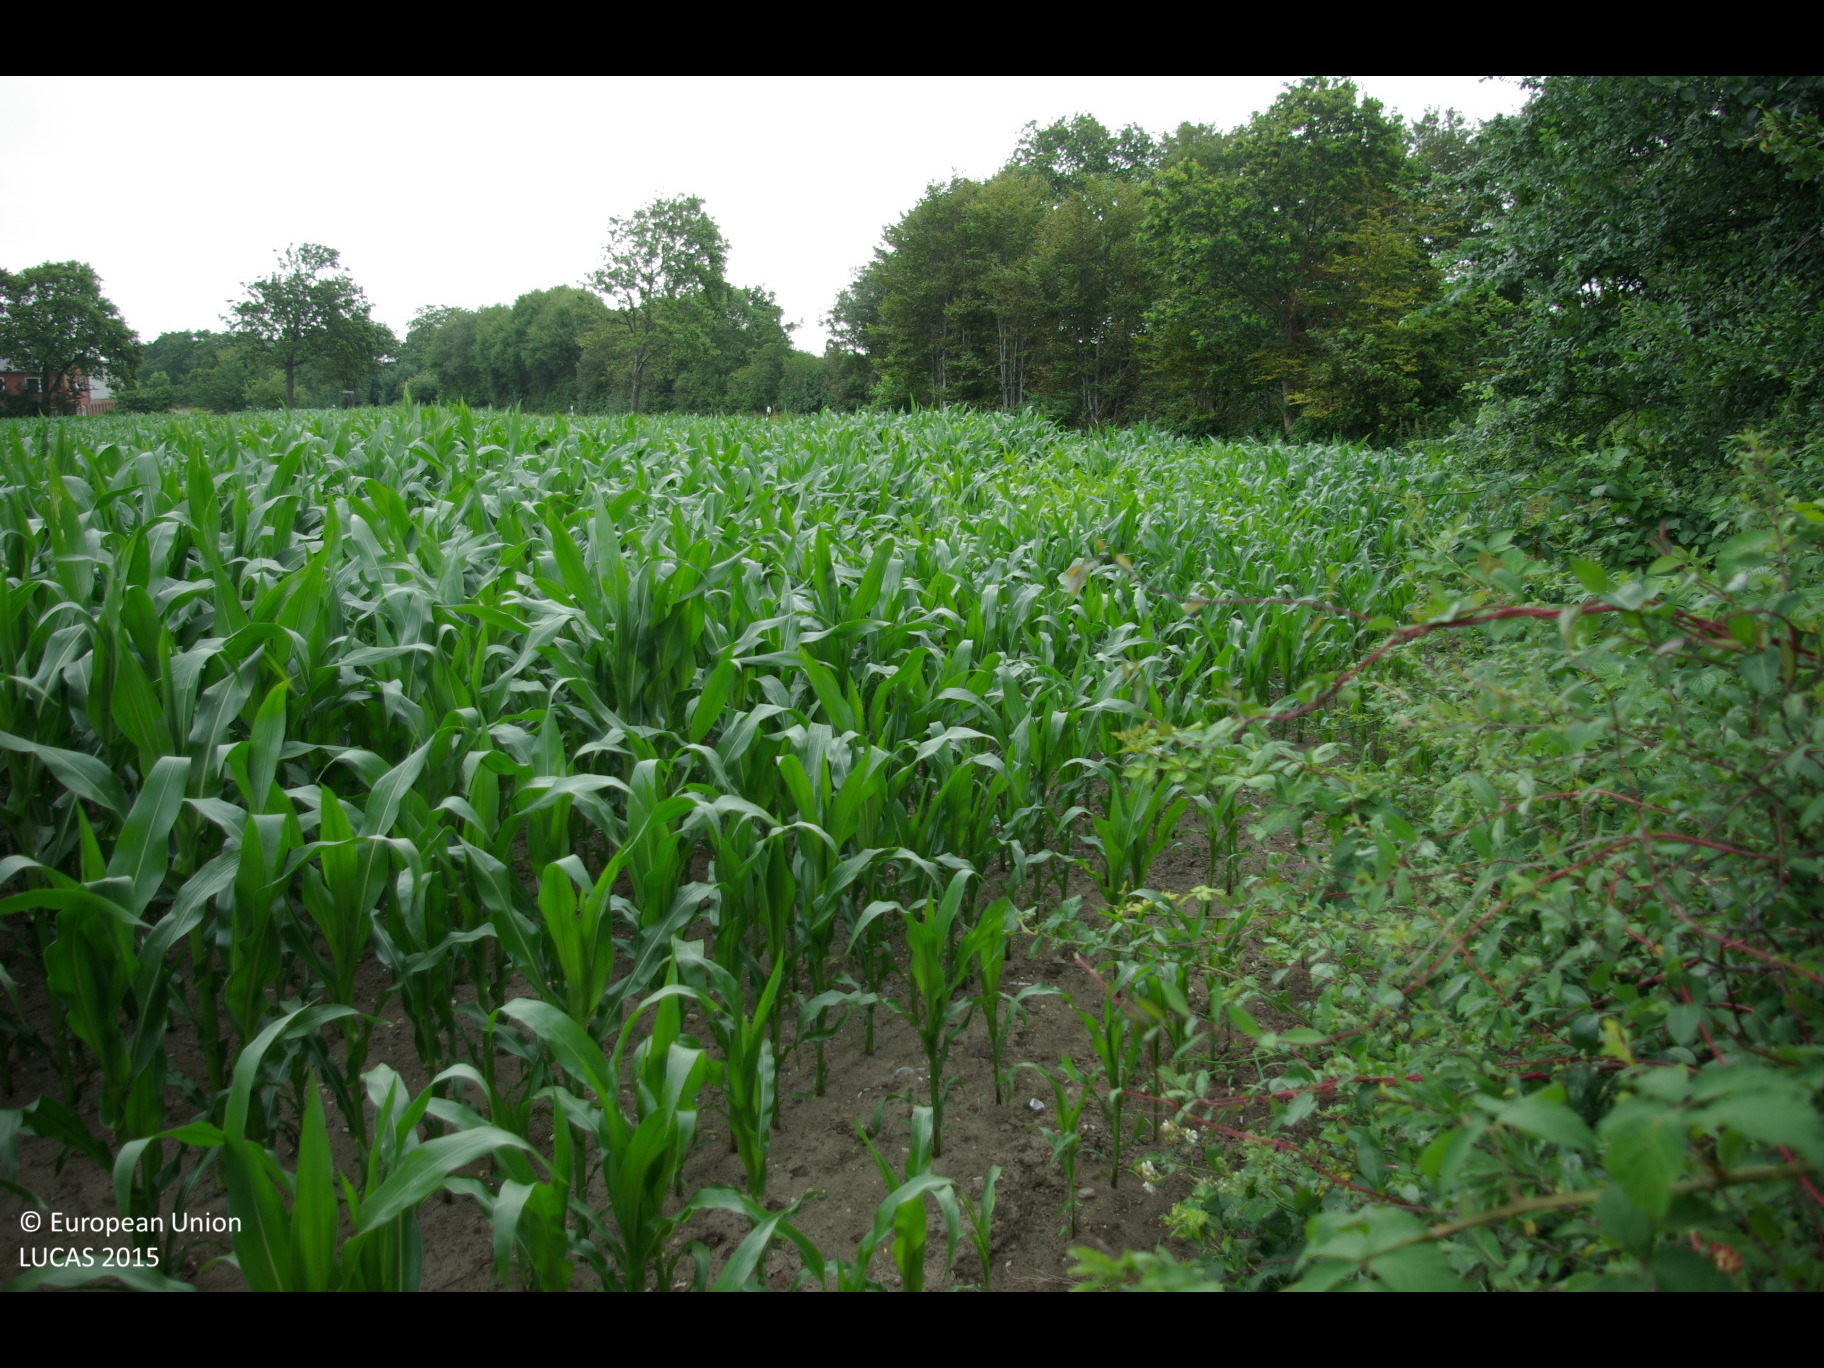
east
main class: Cropland
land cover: Maize
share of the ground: > 75 %
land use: Agriculture (excluding fallow land and kitchen gardens)
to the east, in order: Maize; Shrubland with sparse tree cover; Ditches and canals; Grass margins; Paved roads, cycling and walking lanes; Grass margins; Ditches and canals; Broadleaved woodland; Fences; Grassland without tree/shrub cover; Fences; Maize; Broadleaved woodland; Maize
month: July
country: DE
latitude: 54.1728
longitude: 9.3111
